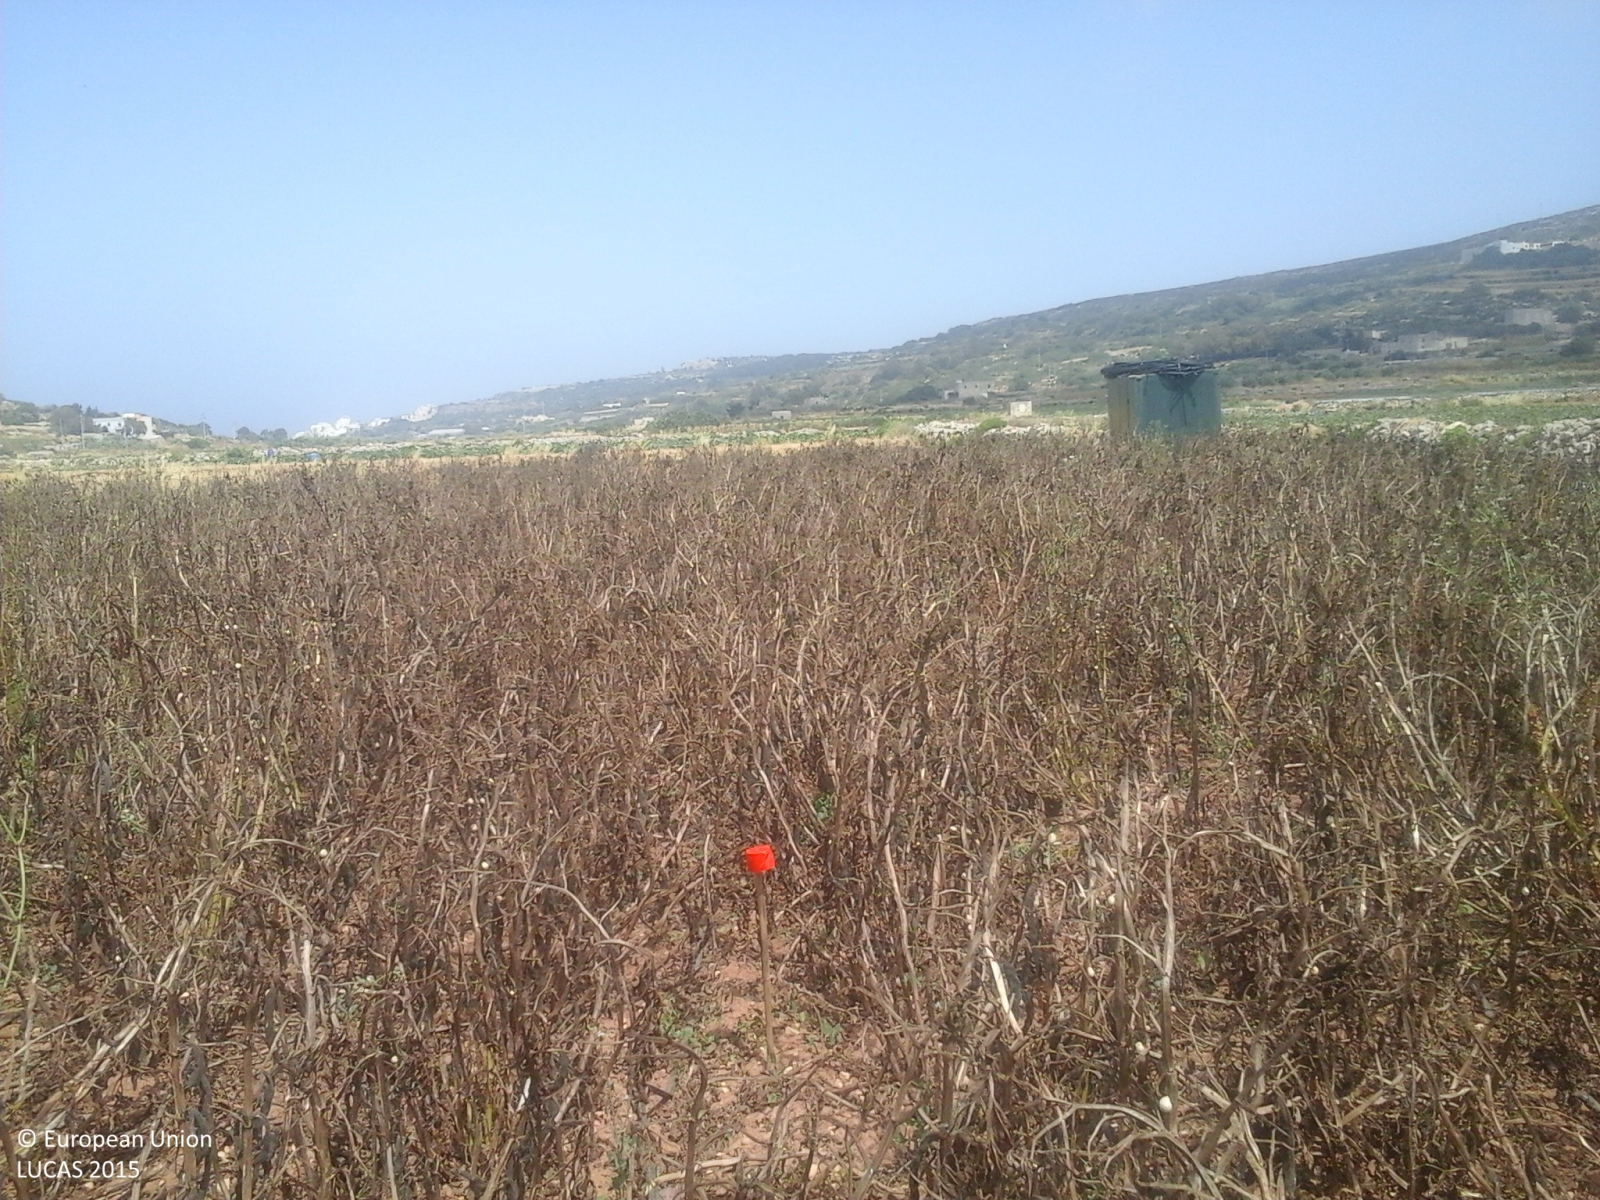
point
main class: Cropland
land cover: Dry pulses
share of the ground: > 75 %
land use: Agriculture (excluding fallow land and kitchen gardens)
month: May
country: MT
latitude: 35.9371
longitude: 14.3604
